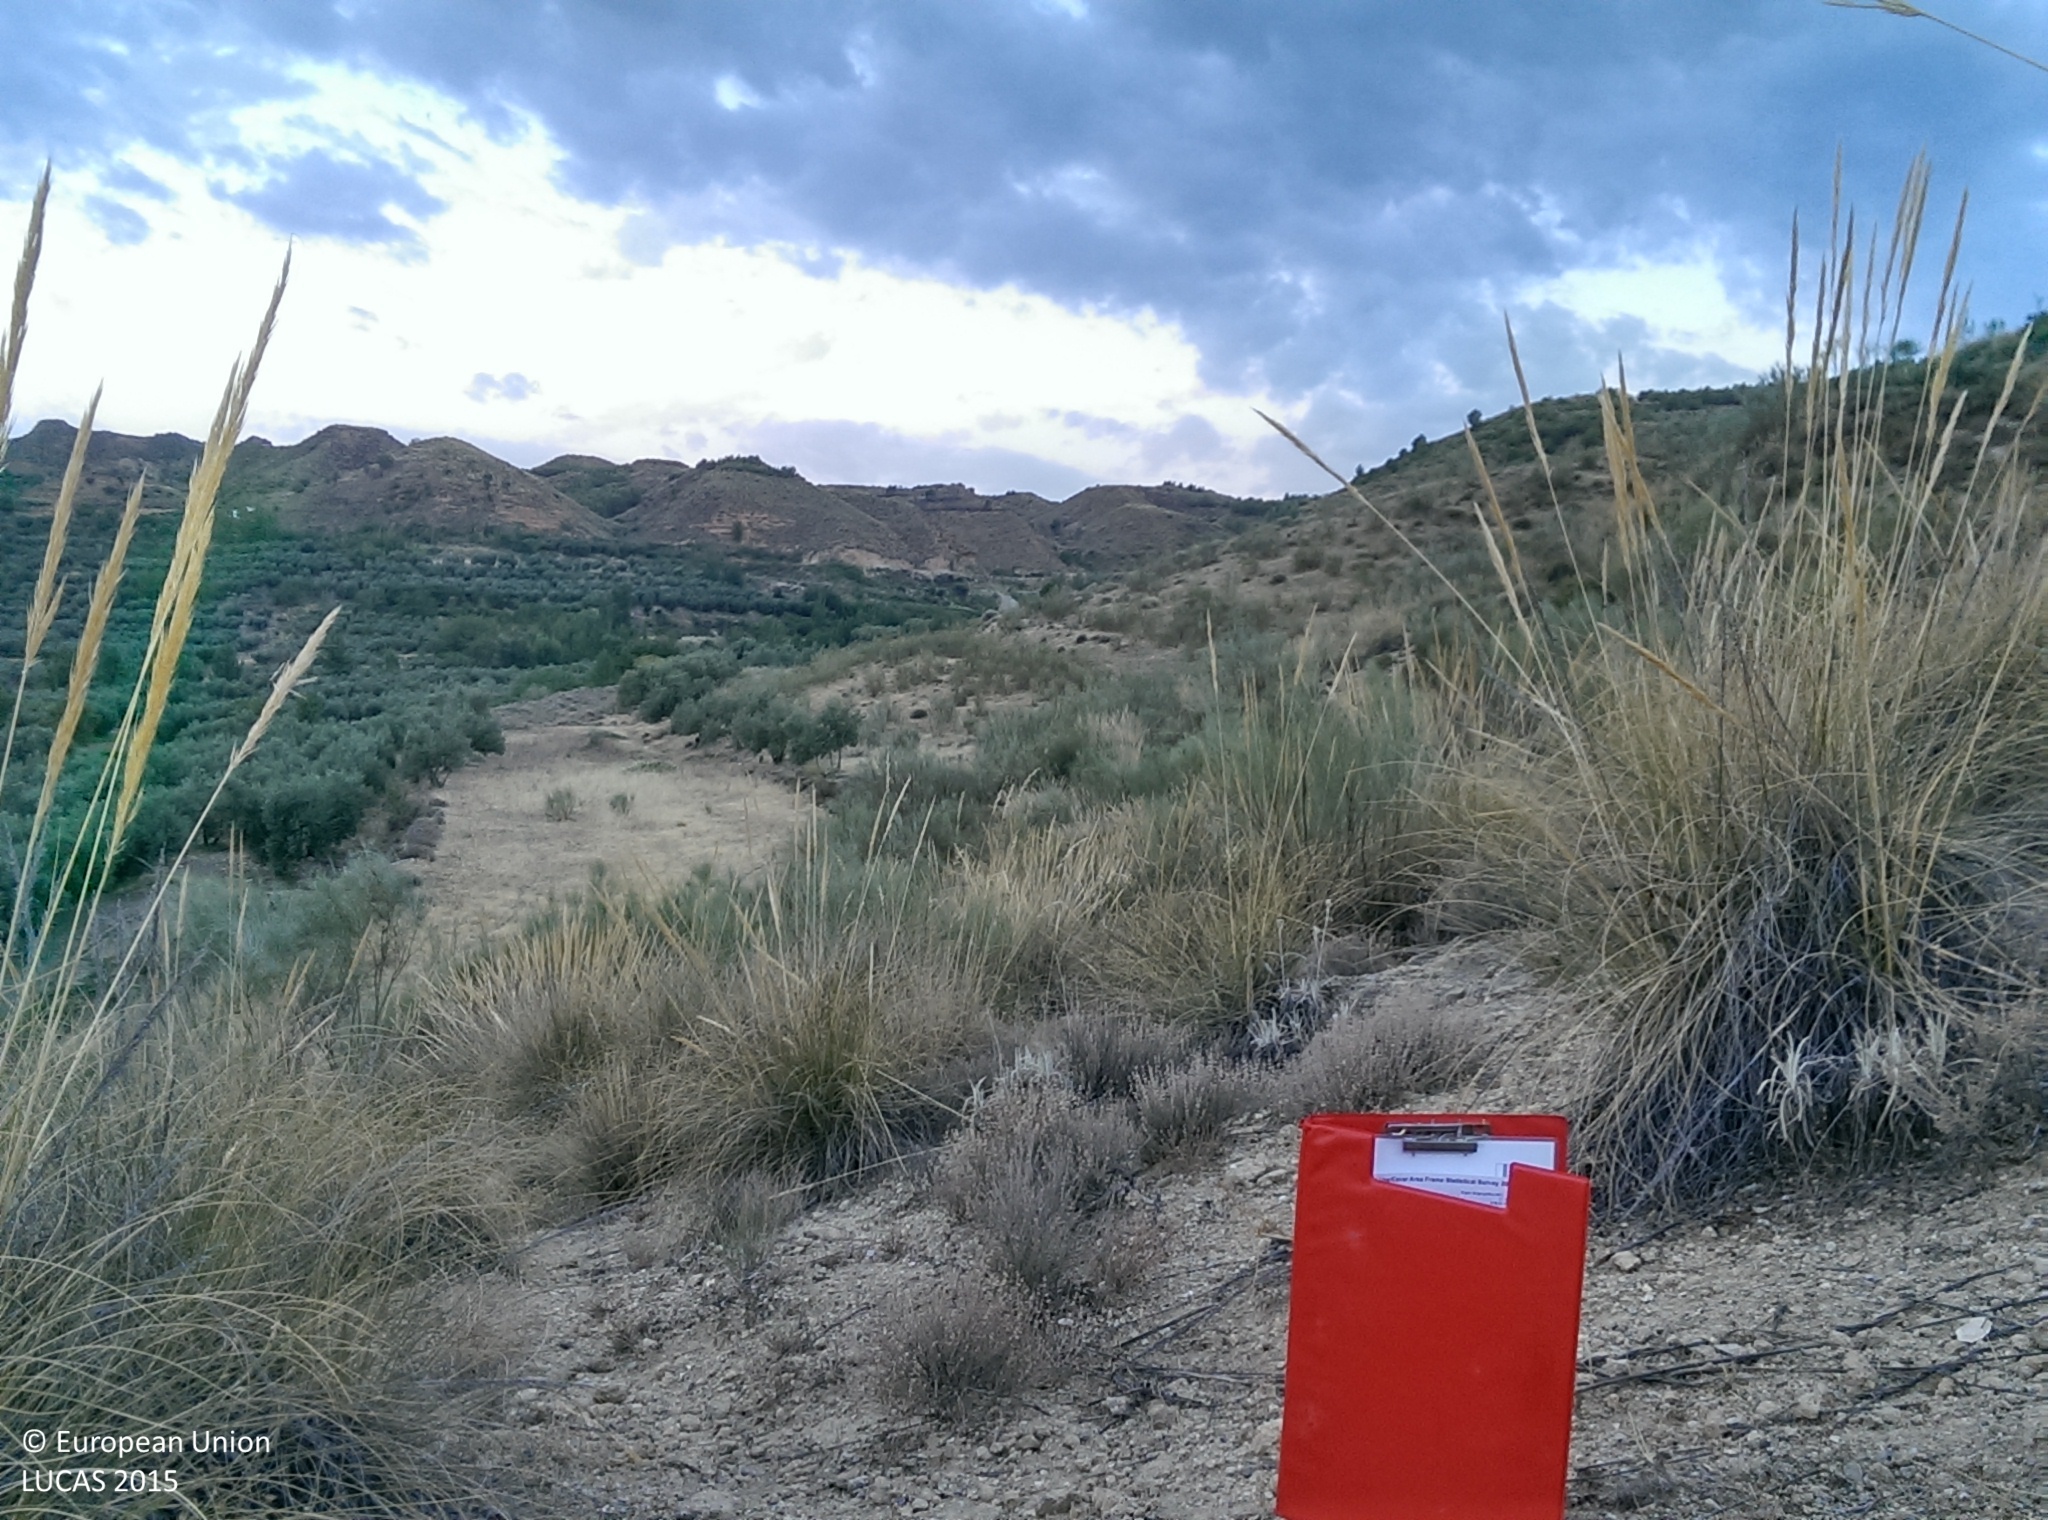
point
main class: Grassland
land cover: Grassland without tree/shrub cover
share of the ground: > 75 %
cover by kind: herbaceous plants 75 %, unconsolidated bare surface 20 %, shrubs 5 %
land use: Semi-natural and natural areas not in use
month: July
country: ES
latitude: 37.3120
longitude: -3.2461
